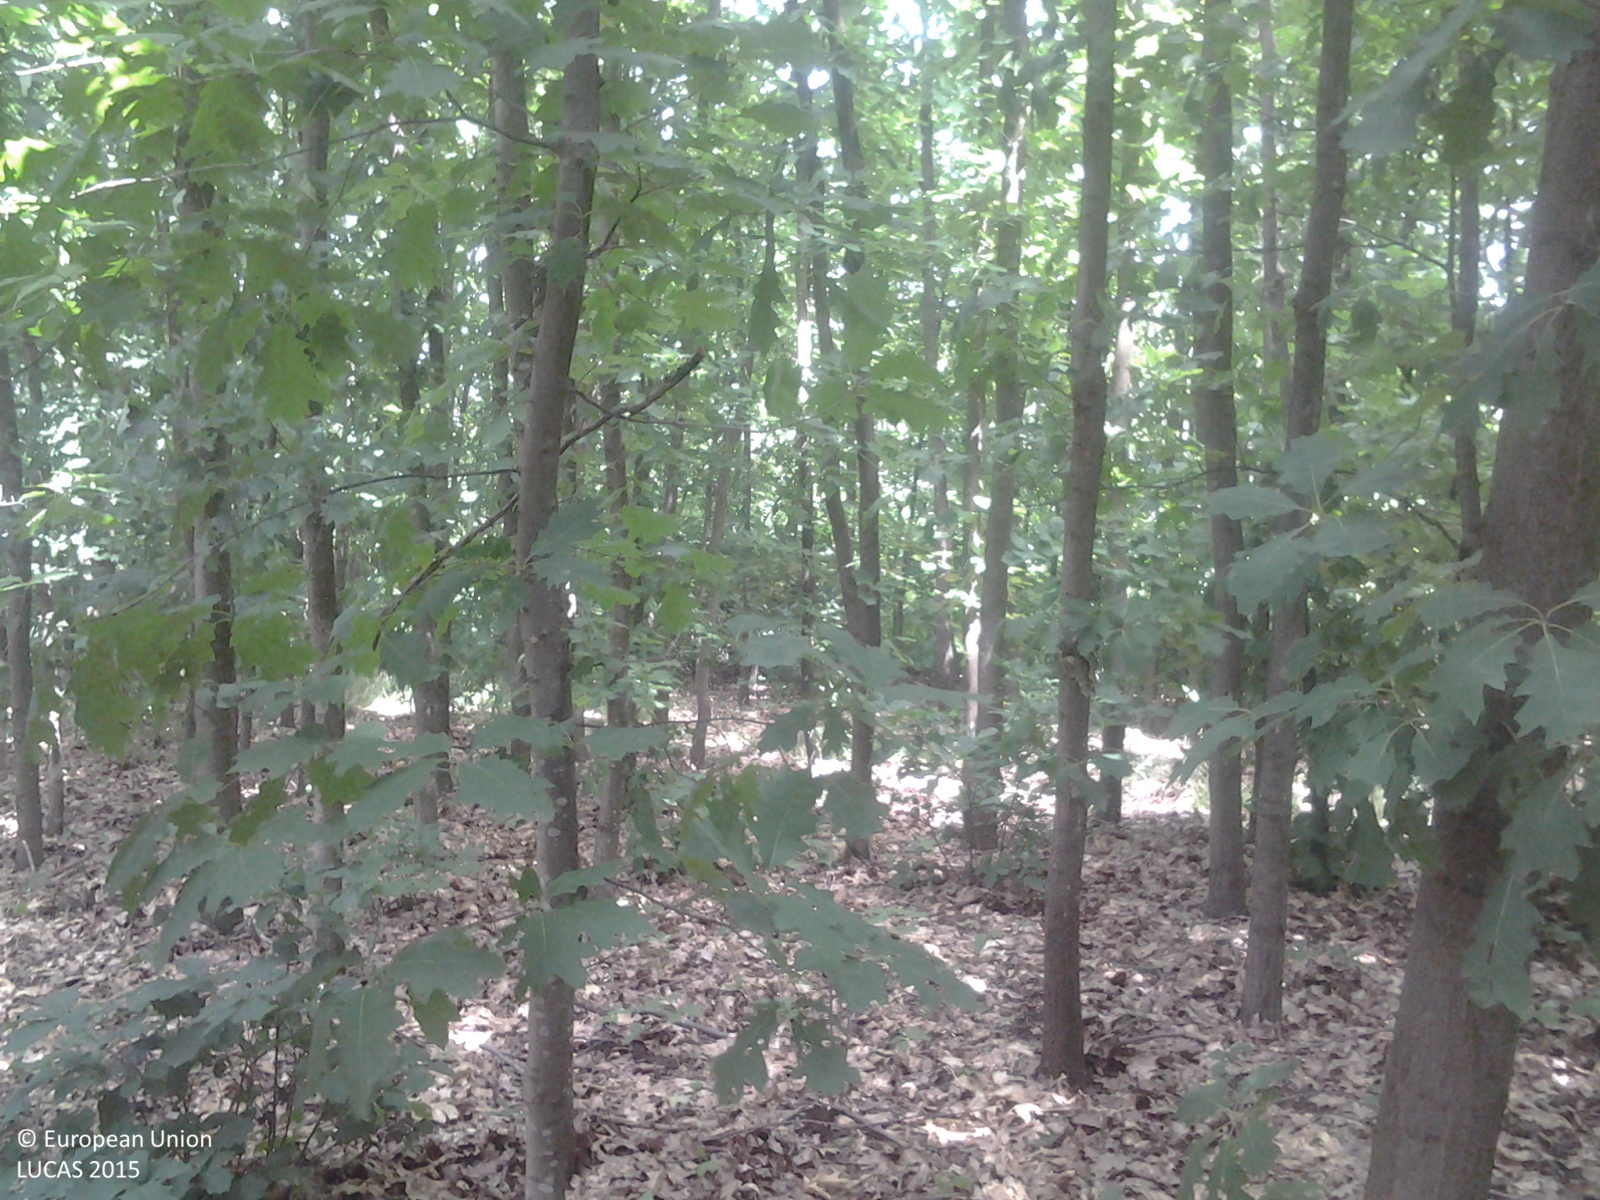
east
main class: Woodland
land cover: Broadleaved woodland
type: acidophilous oak and oak-birch forest
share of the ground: > 75 %
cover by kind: broadleaved forest trees 95 %, unconsolidated bare surface 5 %
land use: Forestry
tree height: > 5 m
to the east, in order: Broadleaved woodland; Tracks; Broadleaved woodland; Ditches and canals; Grass margins; Paved roads, cycling and walking lanes; Grass margins; Ditches and canals; Shrubland without tree cover; Other mixed woodland; Grassland without tree/shrub cover; Electric lines; Grassland without tree/shrub cover; Other mixed woodland
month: June
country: HU
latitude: 46.8672
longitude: 17.2070
